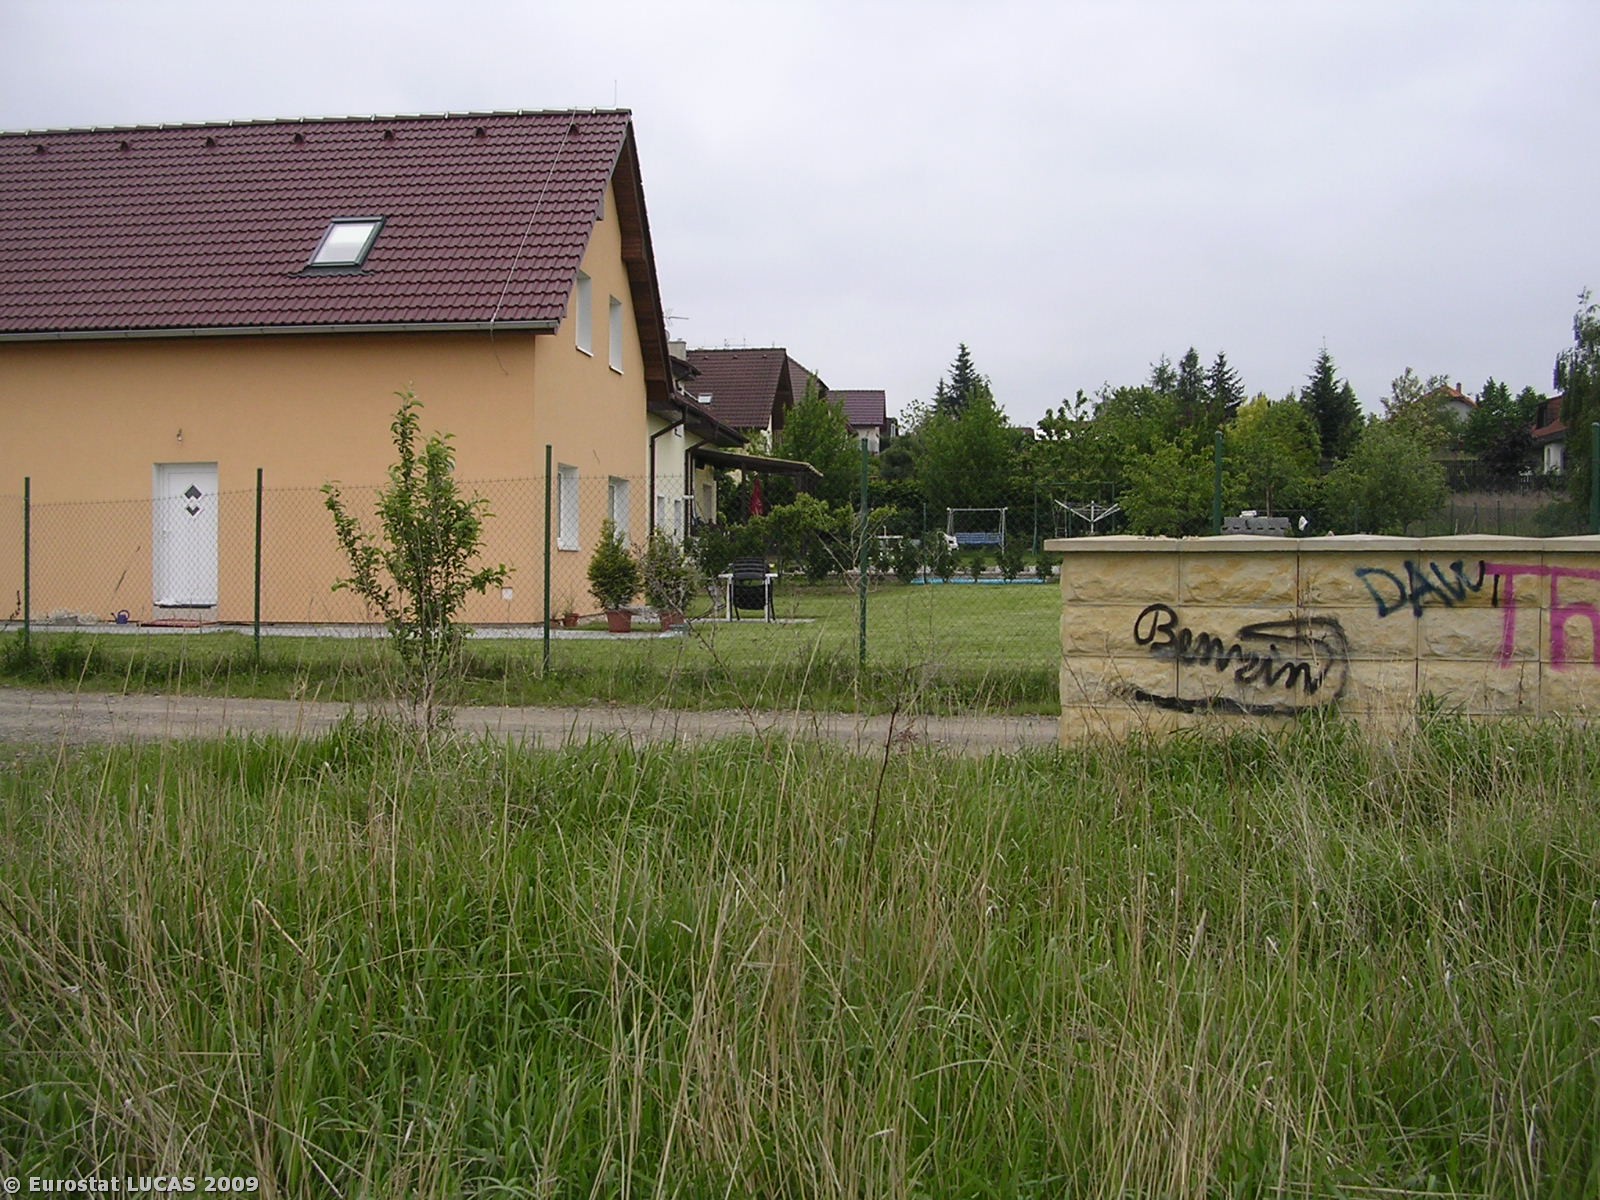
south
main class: Grassland
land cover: Grassland without tree/shrub cover
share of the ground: > 75 %
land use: Fallow land
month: May
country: CZ
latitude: 50.1060
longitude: 14.6860
